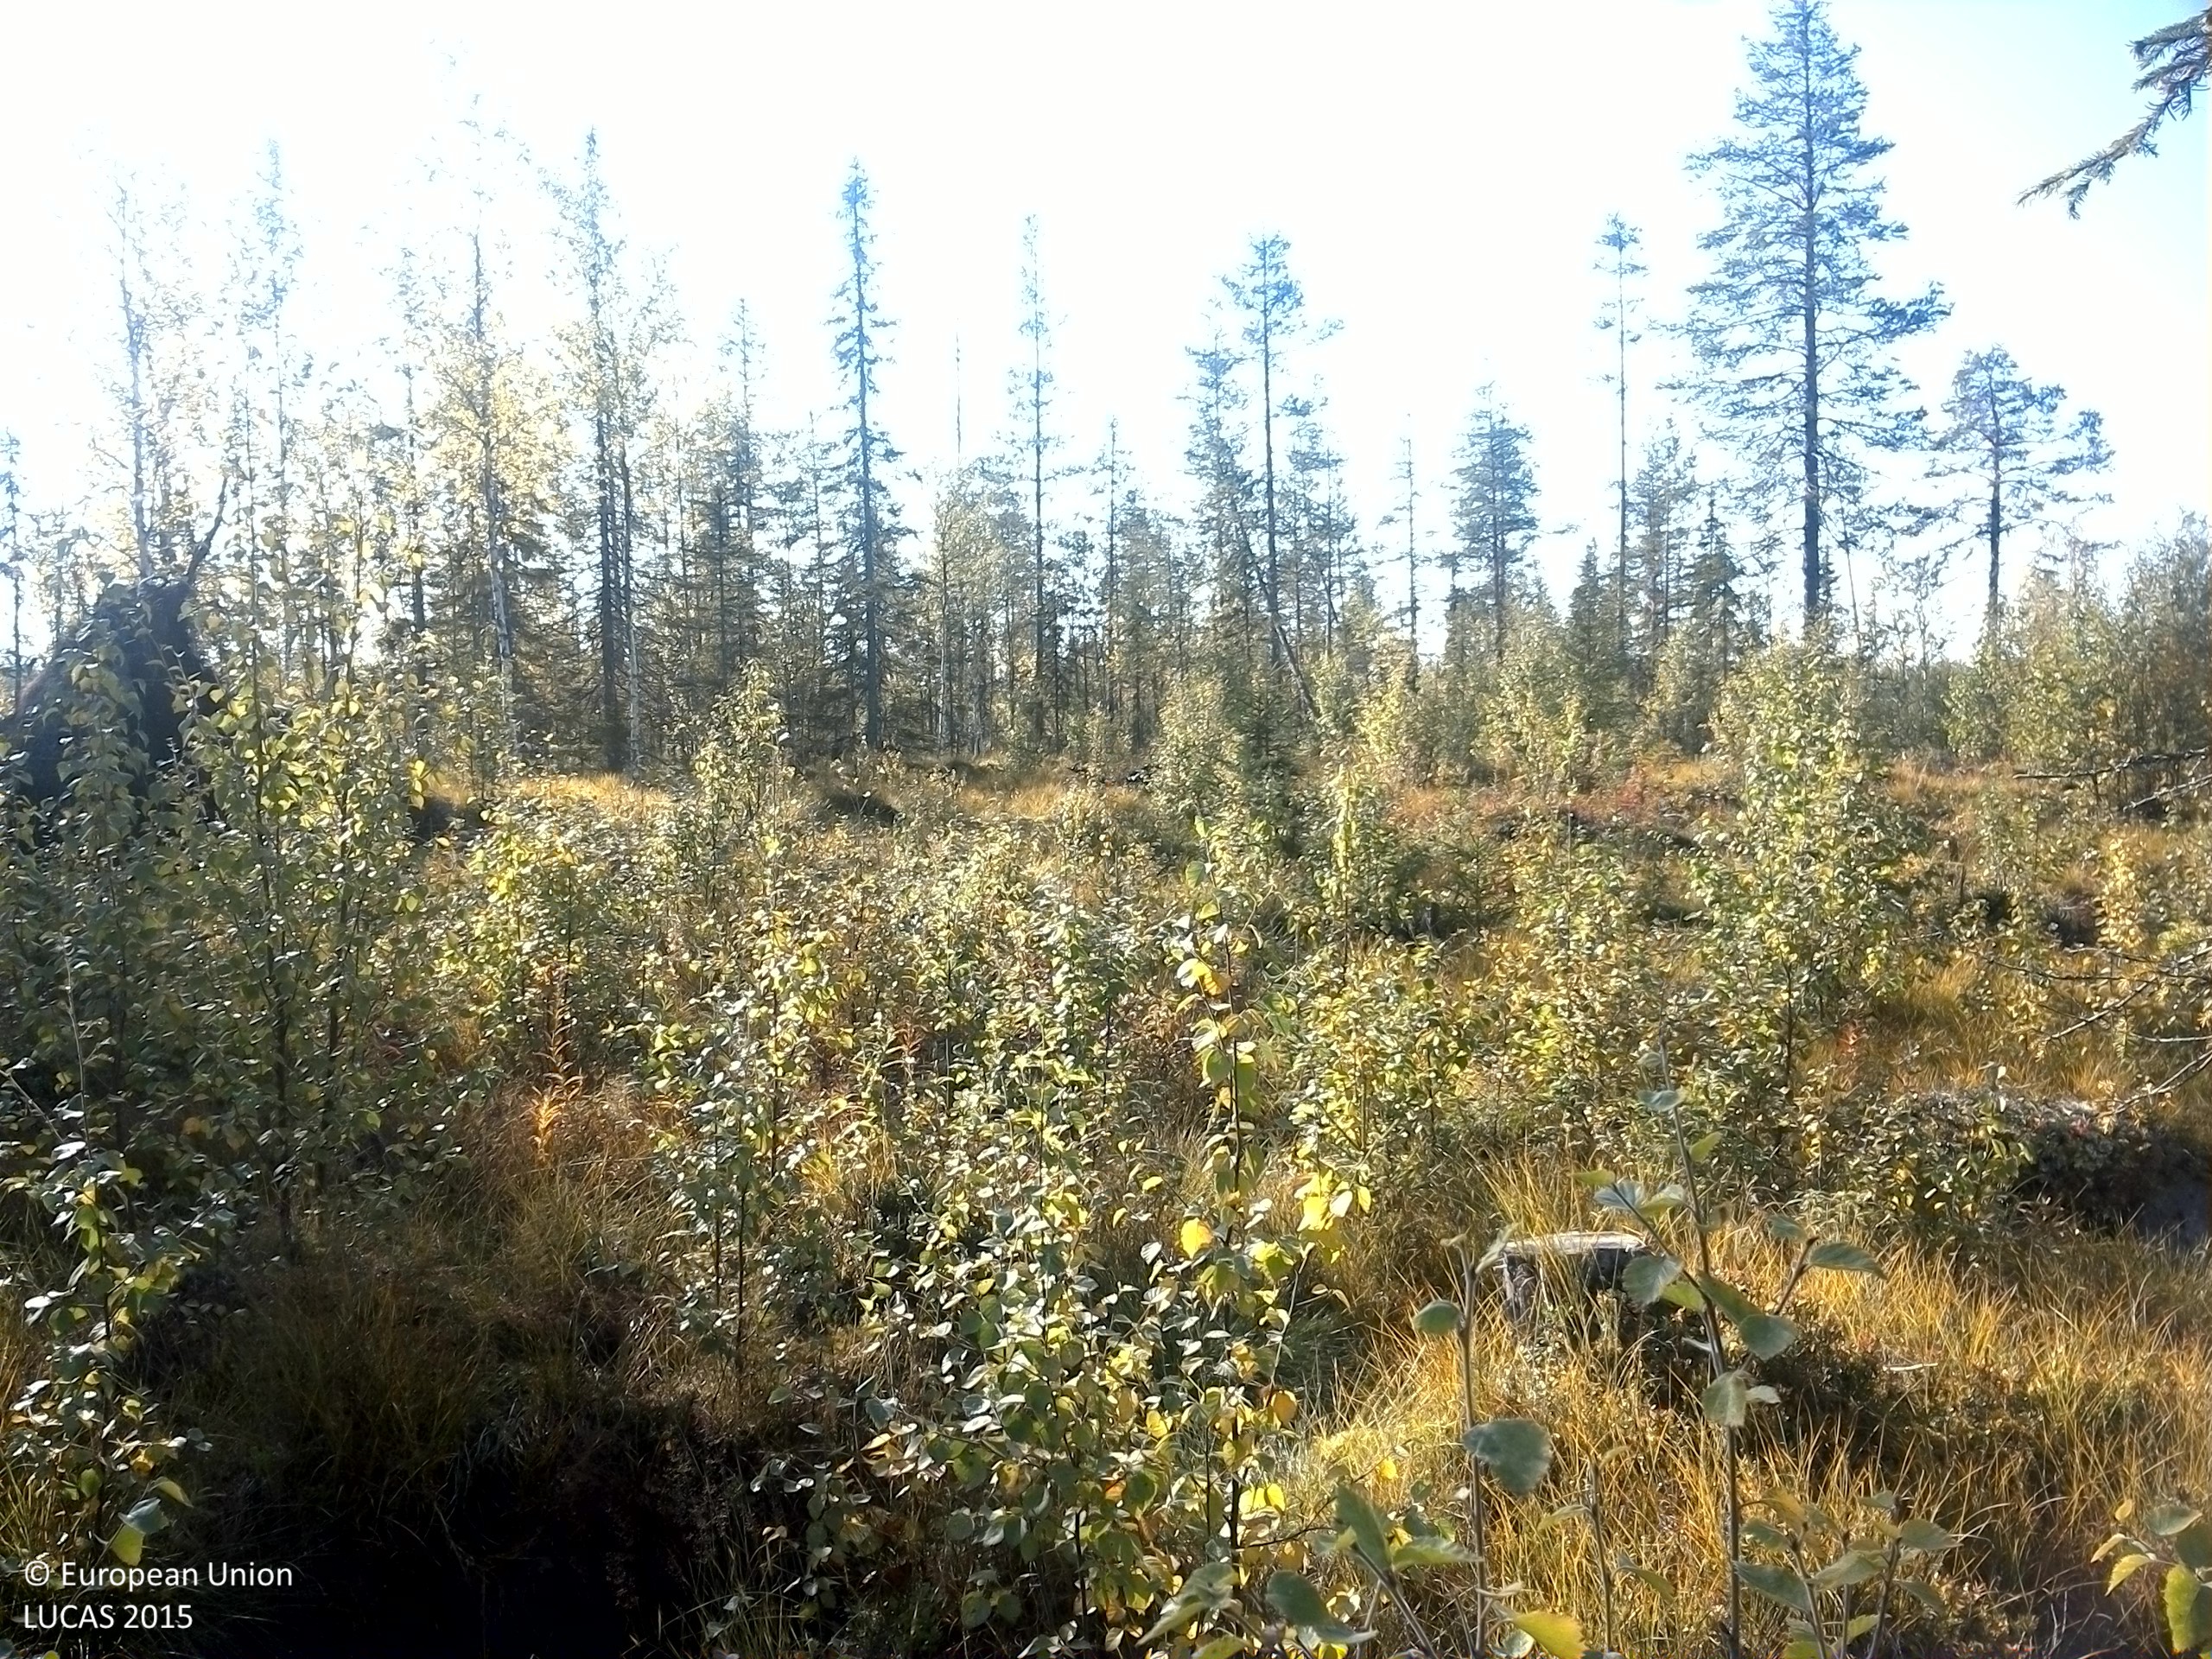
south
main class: Woodland
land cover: Broadleaved woodland
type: boreal forest
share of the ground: 25 - 50 %
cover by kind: broadleaved forest trees 35 %, herbaceous plants 35 %, coniferous forest trees 10 %, shrubs 10 %, lichens and mosses 5 %, unconsolidated bare surface 5 %
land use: Forestry
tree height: < 5 m
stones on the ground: < 10 %
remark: Clear cut
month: September
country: SE
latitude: 64.0636
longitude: 16.5485
